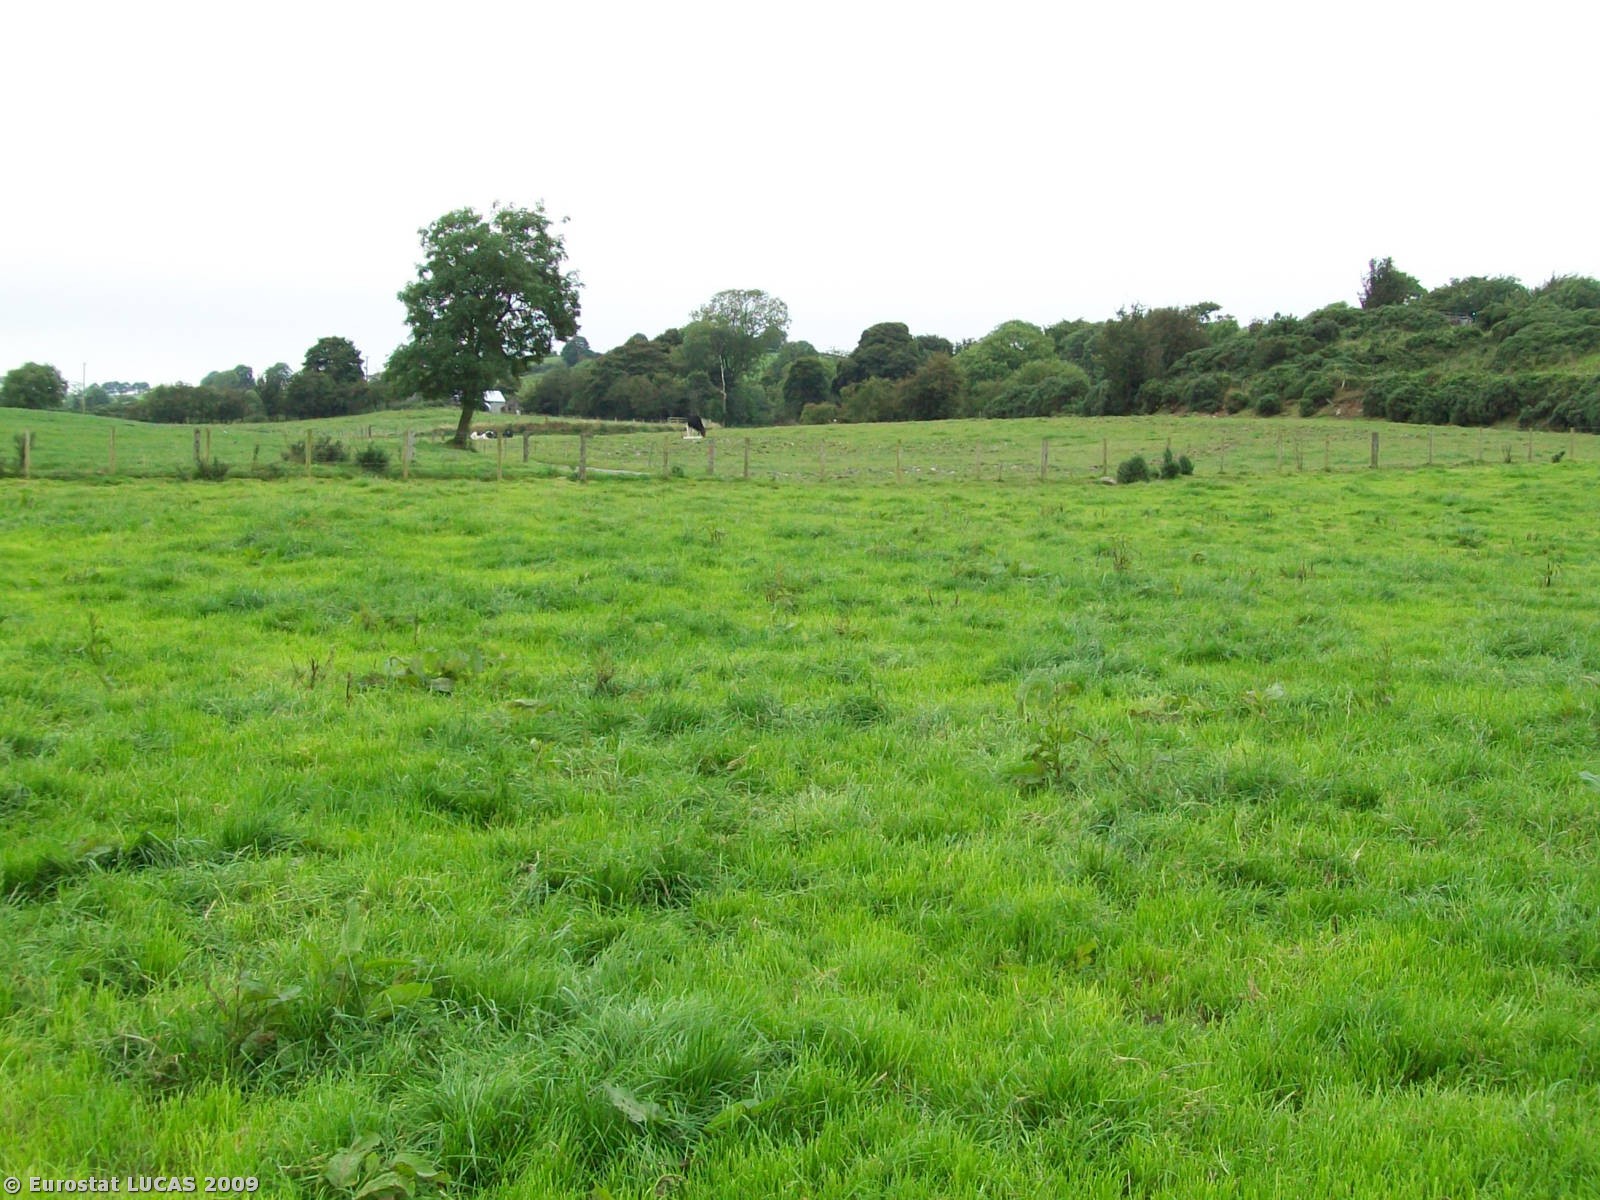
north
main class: Grassland
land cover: Grassland without tree/shrub cover
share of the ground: > 75 %
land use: Agriculture (excluding fallow land and kitchen gardens)
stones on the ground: 10 - 25 %
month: August
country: GB
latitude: 54.1712
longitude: -6.6271
